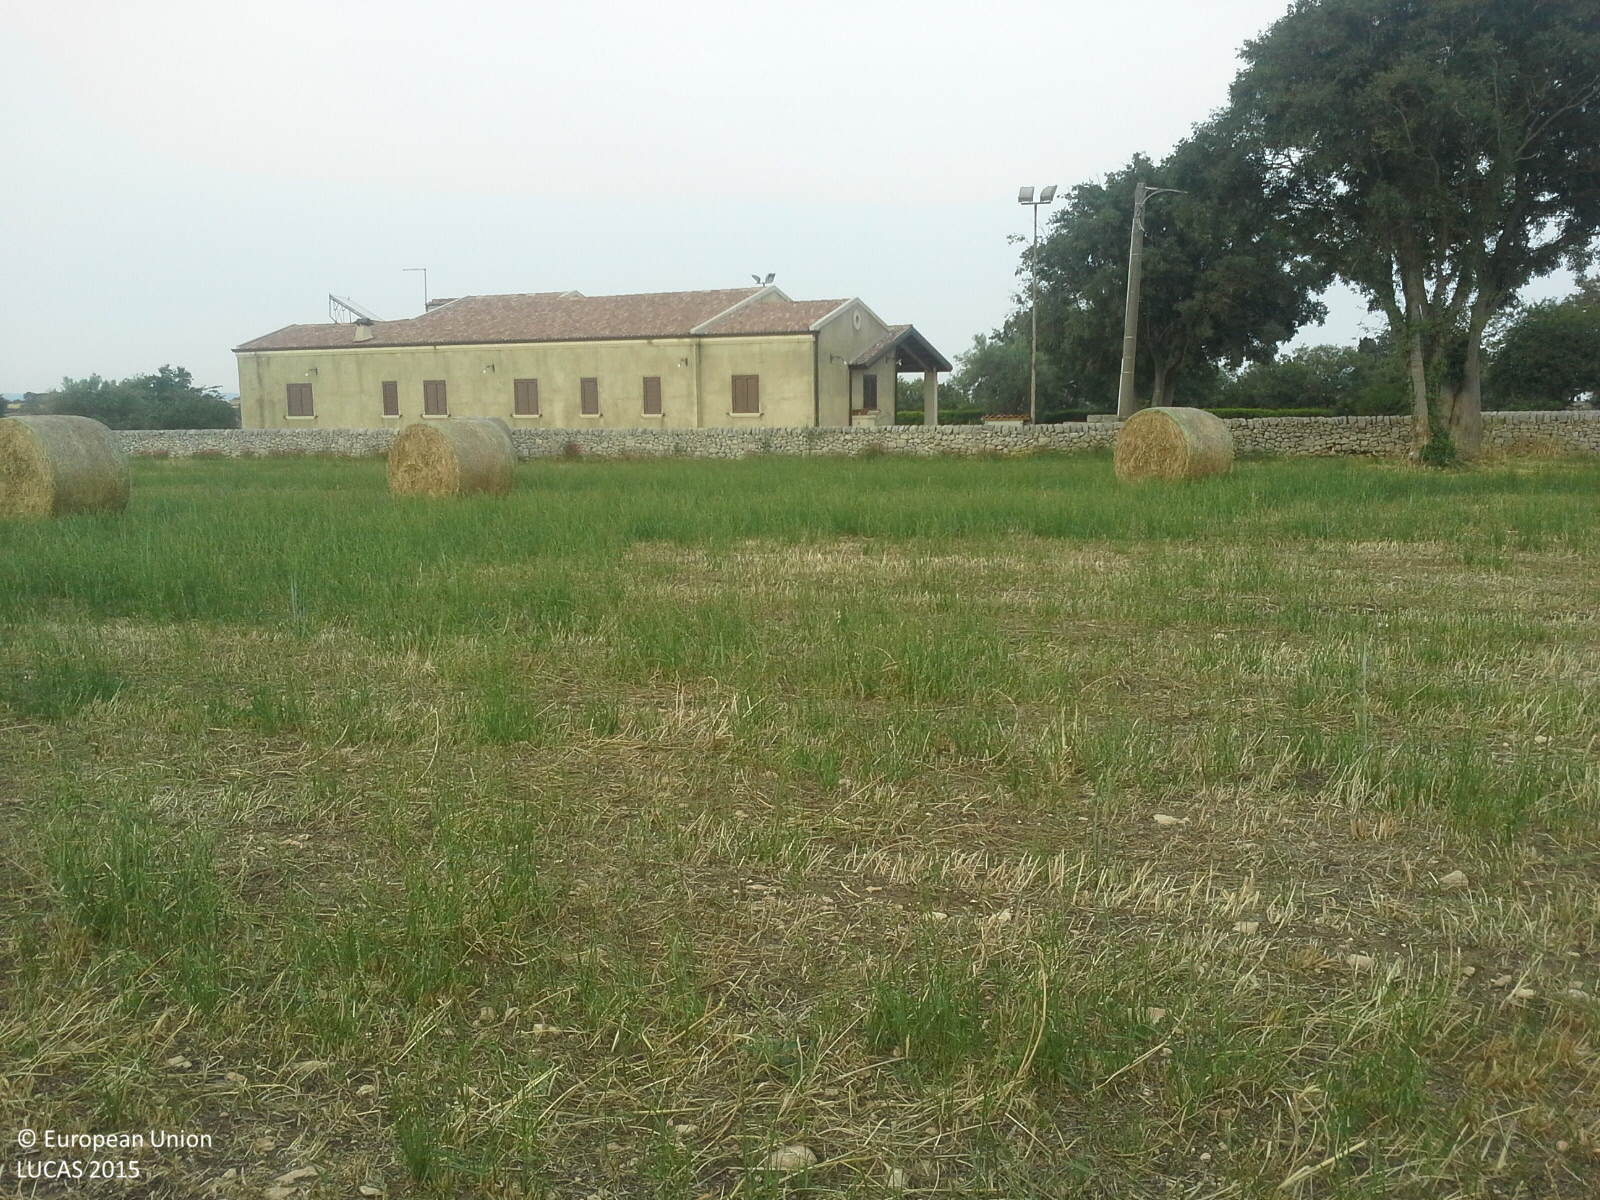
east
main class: Cropland
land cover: Mixed cereals for fodder
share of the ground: > 75 %
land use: Agriculture (excluding fallow land and kitchen gardens)
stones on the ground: < 10 %
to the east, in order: Mixed cereals for fodder; Artificial constructions in urban areas; Managed hedges; Grassland without tree/shrub cover; Dry stone walls; Managed hedges; Durum wheat
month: May
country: IT
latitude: 36.8795
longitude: 14.8196
